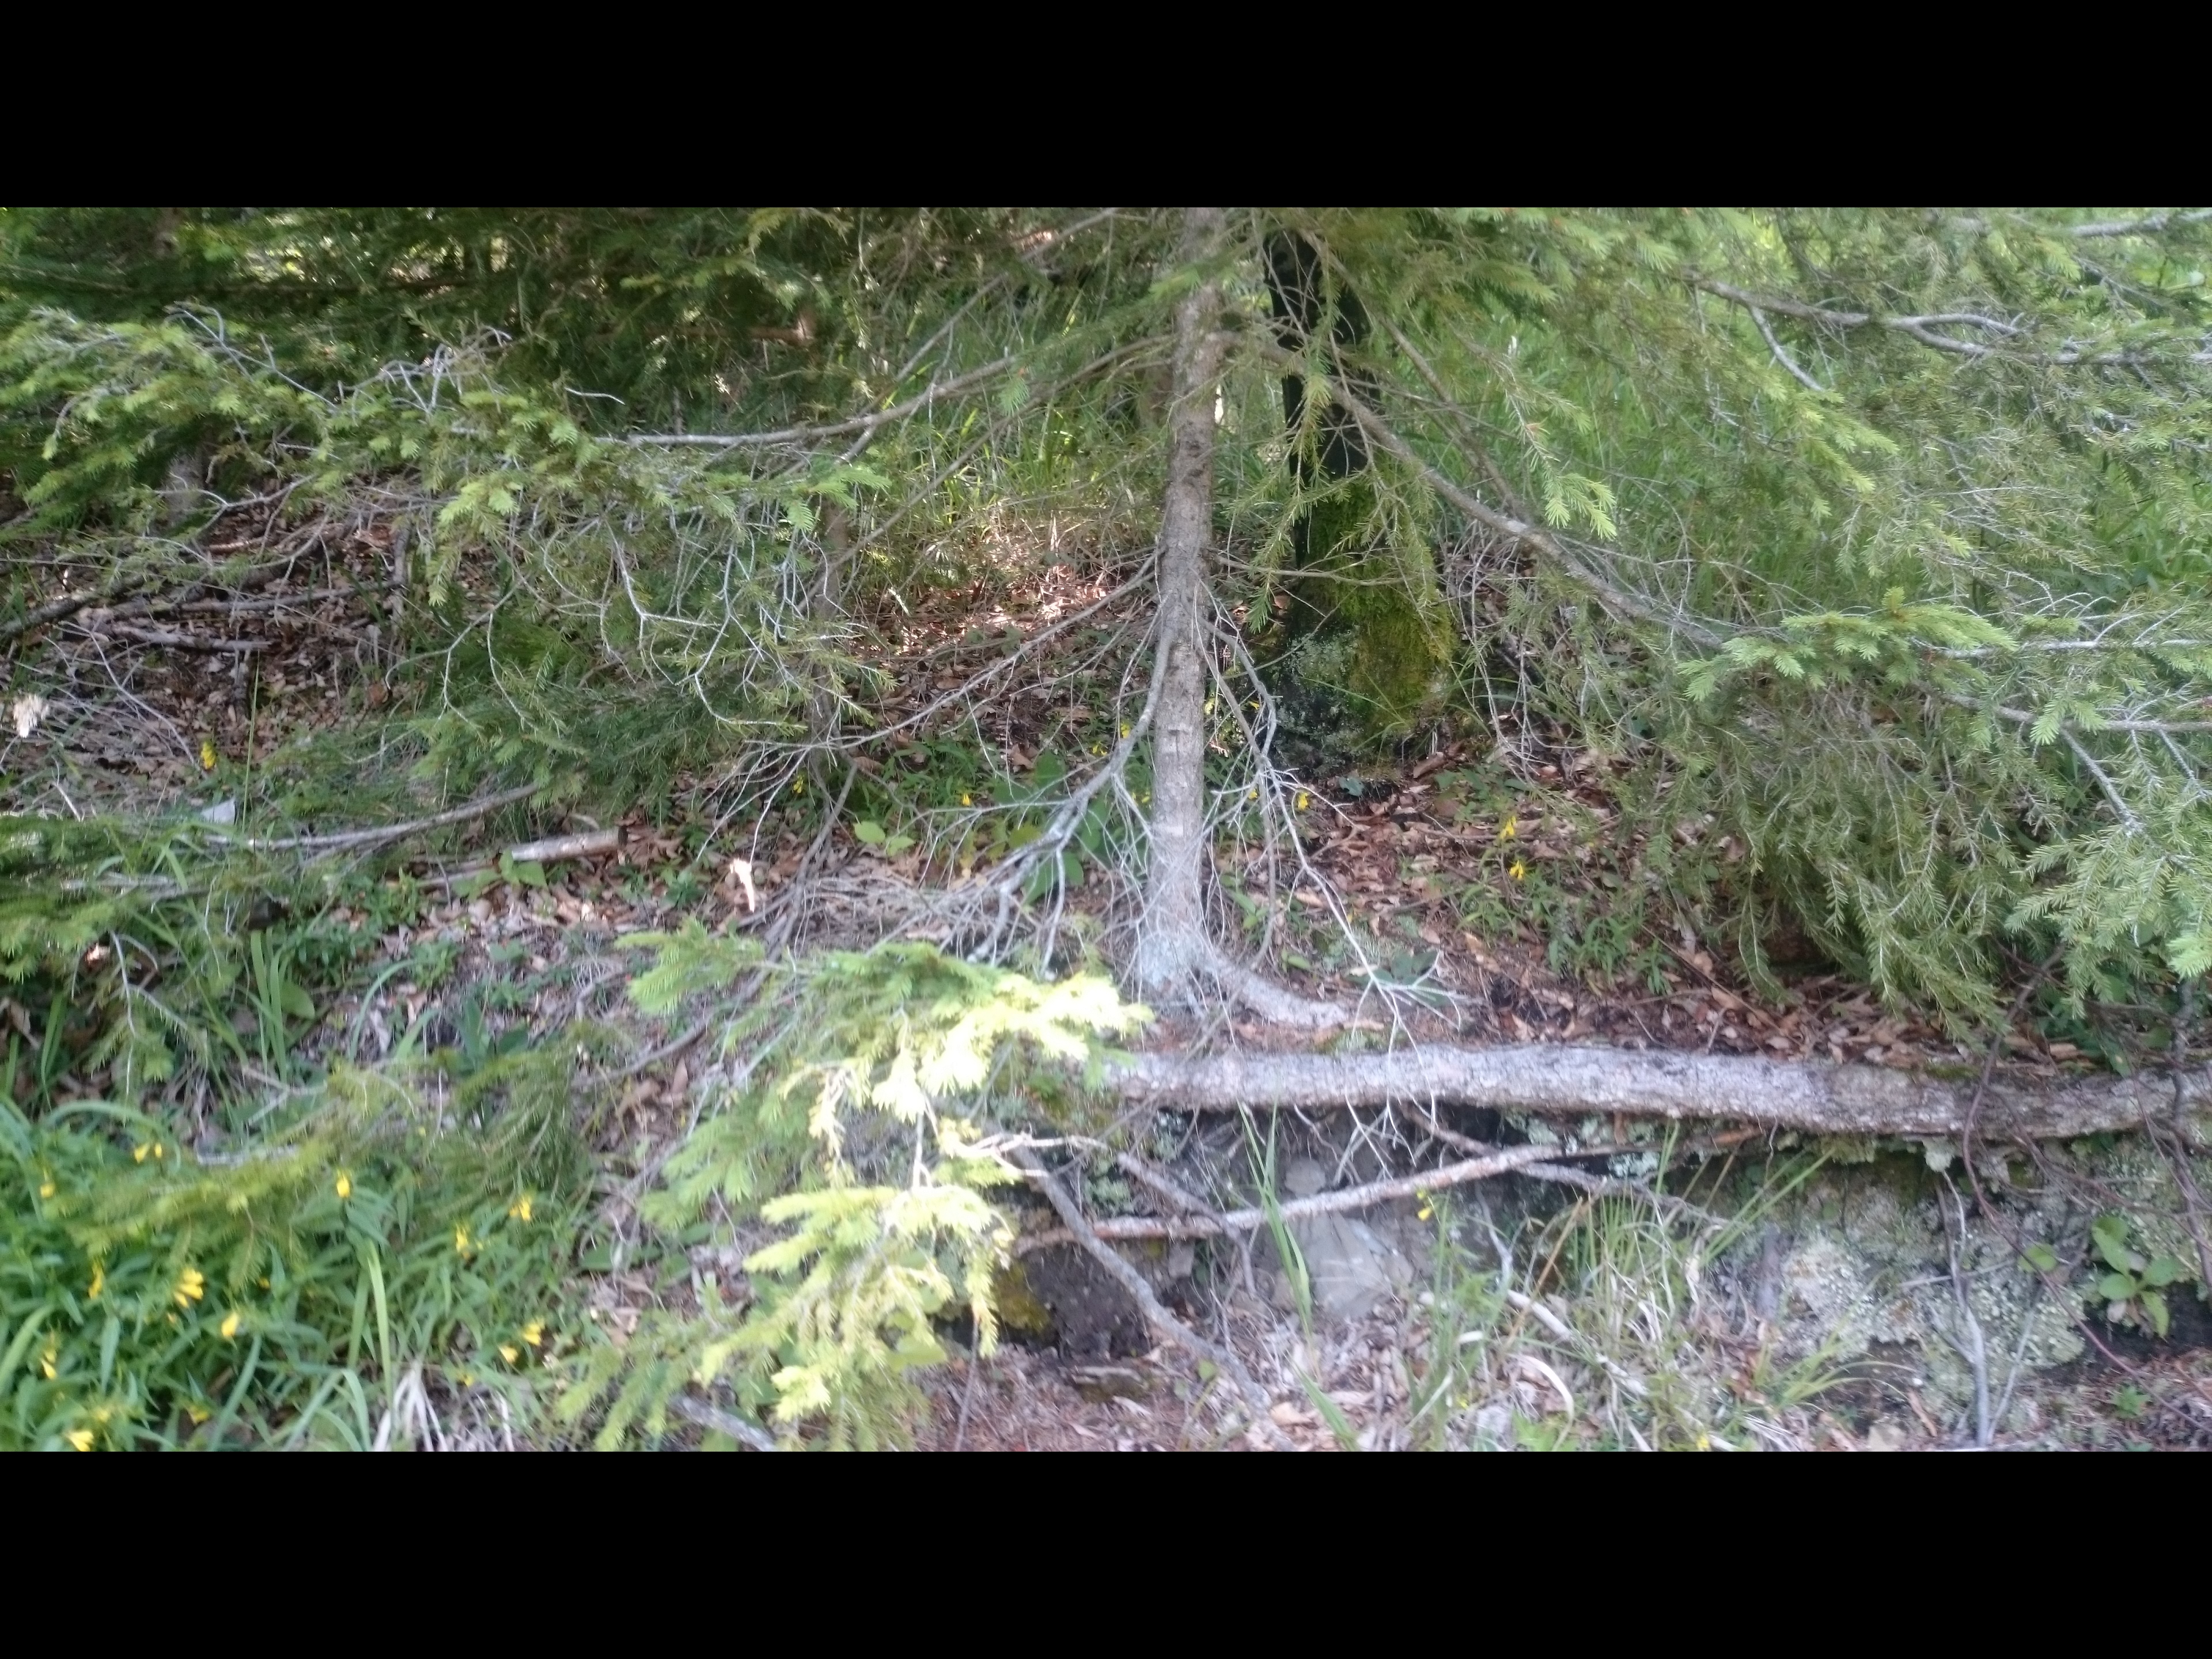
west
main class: Woodland
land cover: Spruce dominated mixed woodland
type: hemiboreal forest and nemoral coniferous forest and mixed broadleaved-coniferous forest
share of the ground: > 75 %
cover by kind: coniferous forest trees 65 %, broadleaved forest trees 25 %, herbaceous plants 10 %
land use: Forestry
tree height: > 5 m
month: July
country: AT
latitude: 47.1855
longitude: 15.4769
